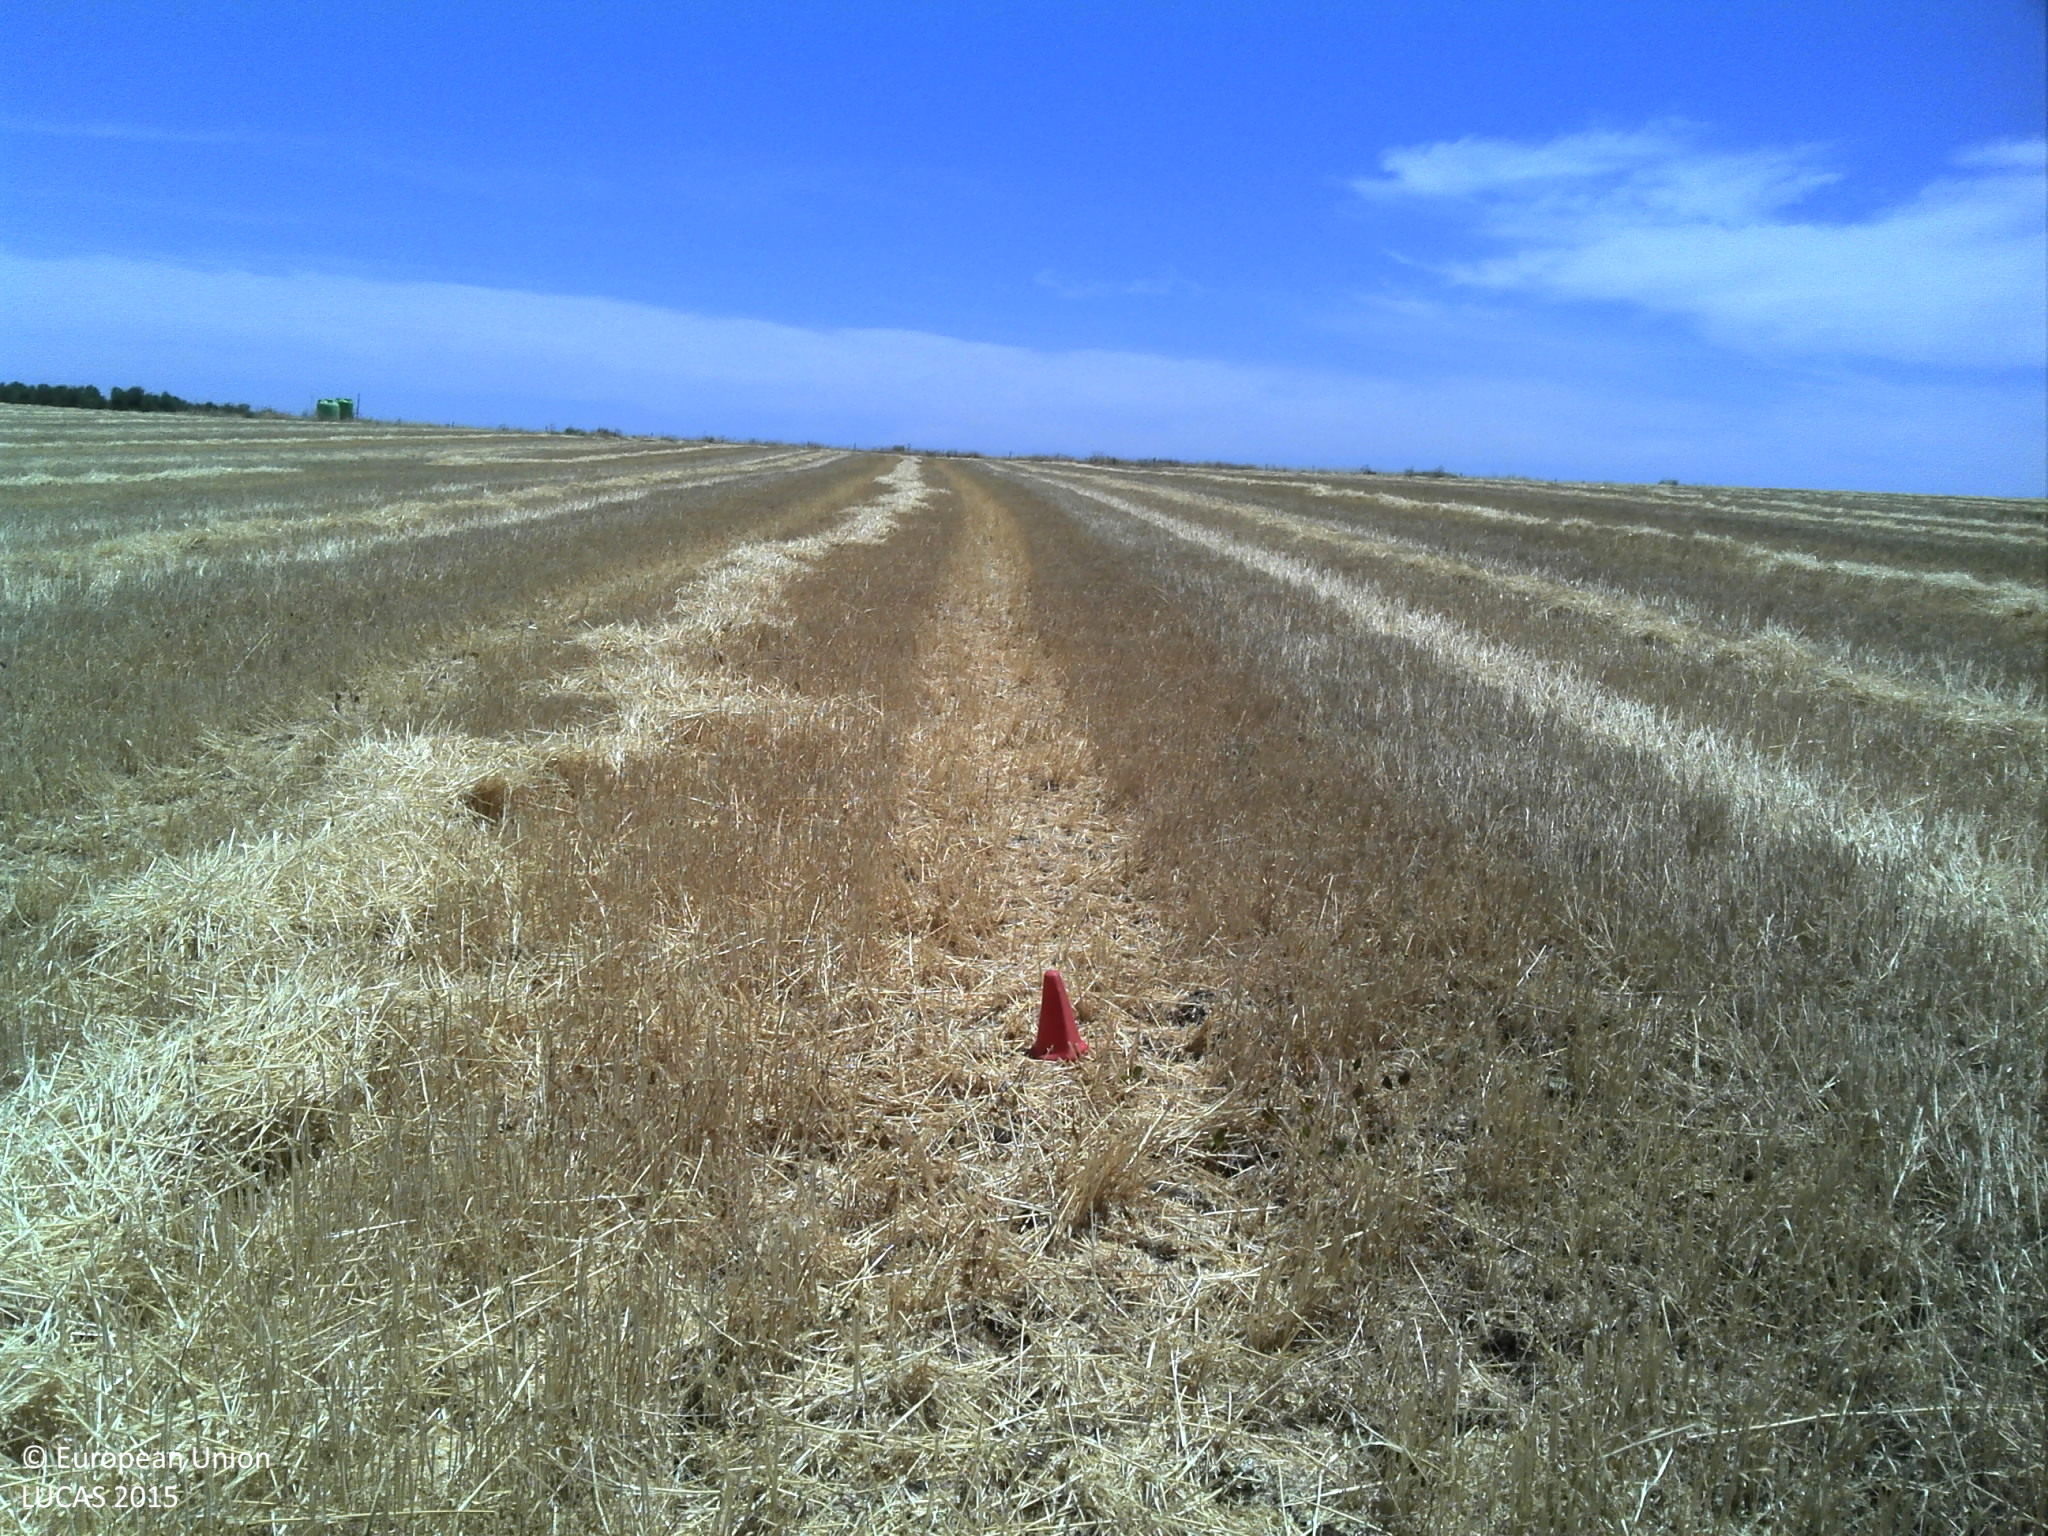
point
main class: Cropland
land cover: Common wheat
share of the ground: > 75 %
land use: Agriculture (excluding fallow land and kitchen gardens)
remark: Harvested field
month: June
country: PT
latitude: 37.9362
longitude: -7.5294
